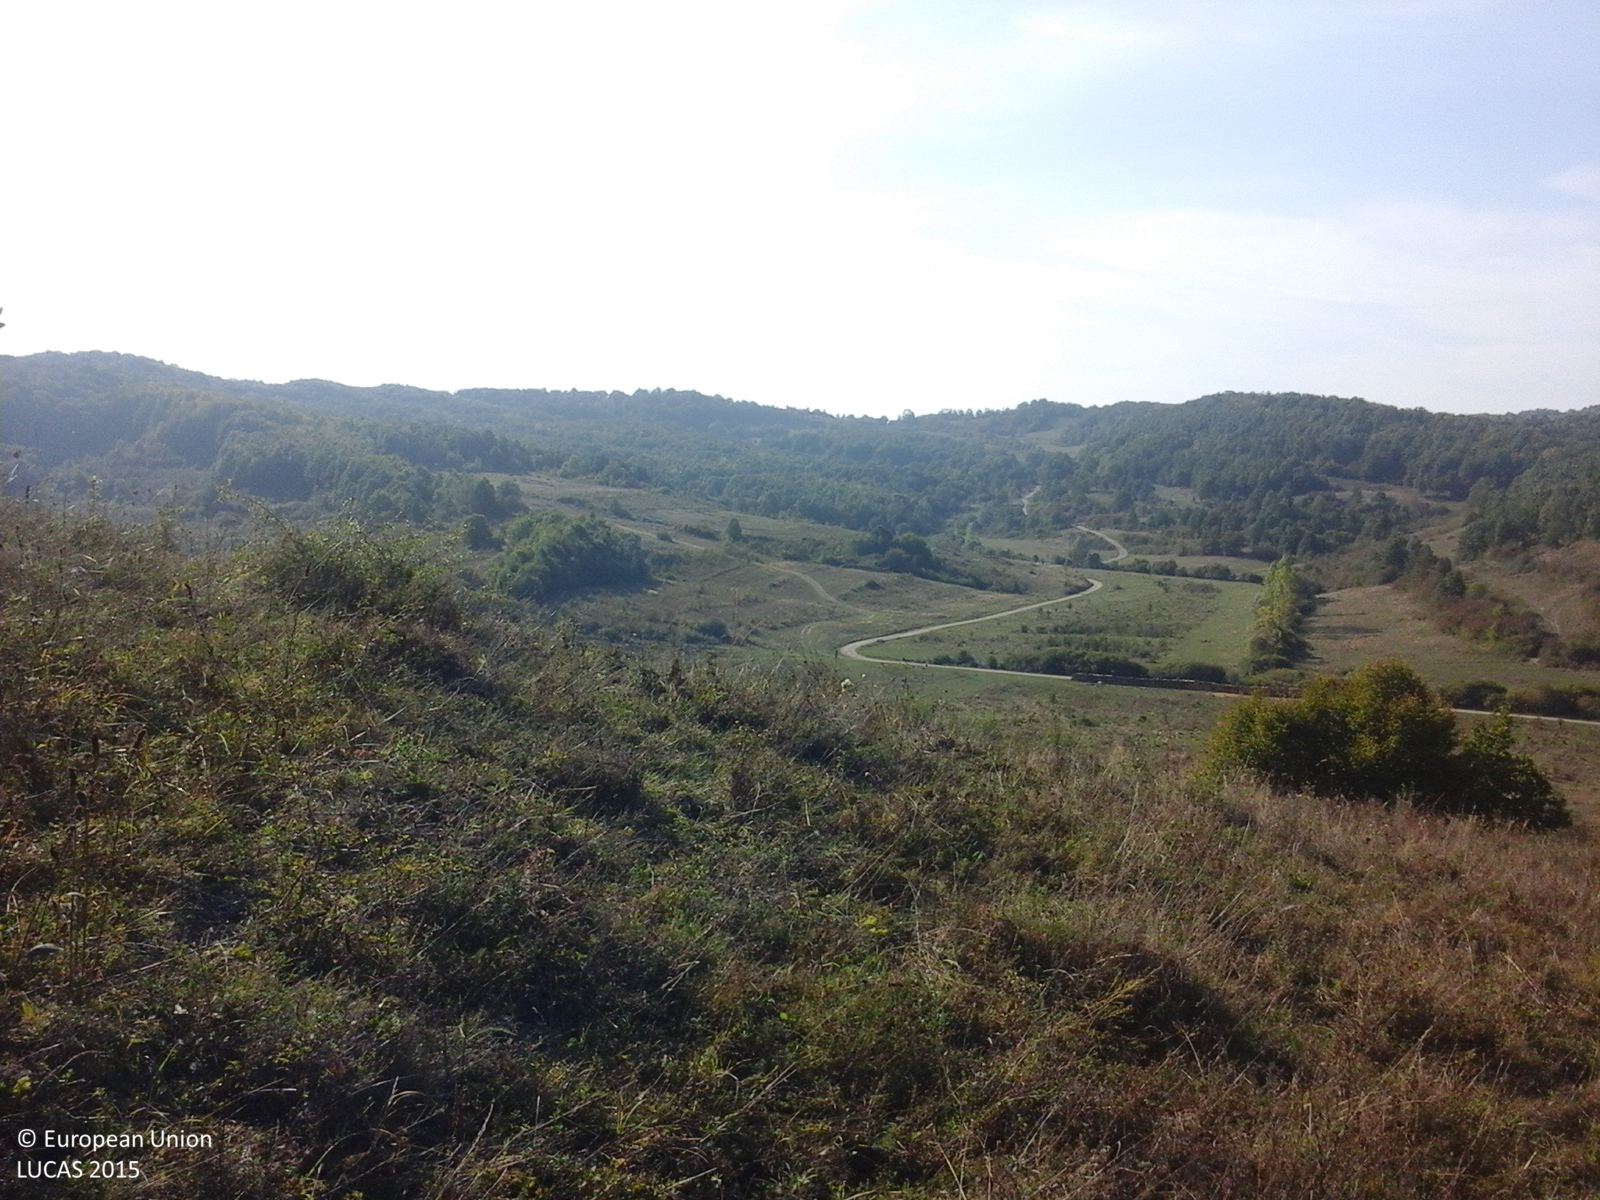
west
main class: Grassland
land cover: Spontaneously vegetated surfaces
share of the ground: > 75 %
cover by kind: herbaceous plants 100 %
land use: Fallow land
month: September
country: RO
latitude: 47.3420
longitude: 23.7229
